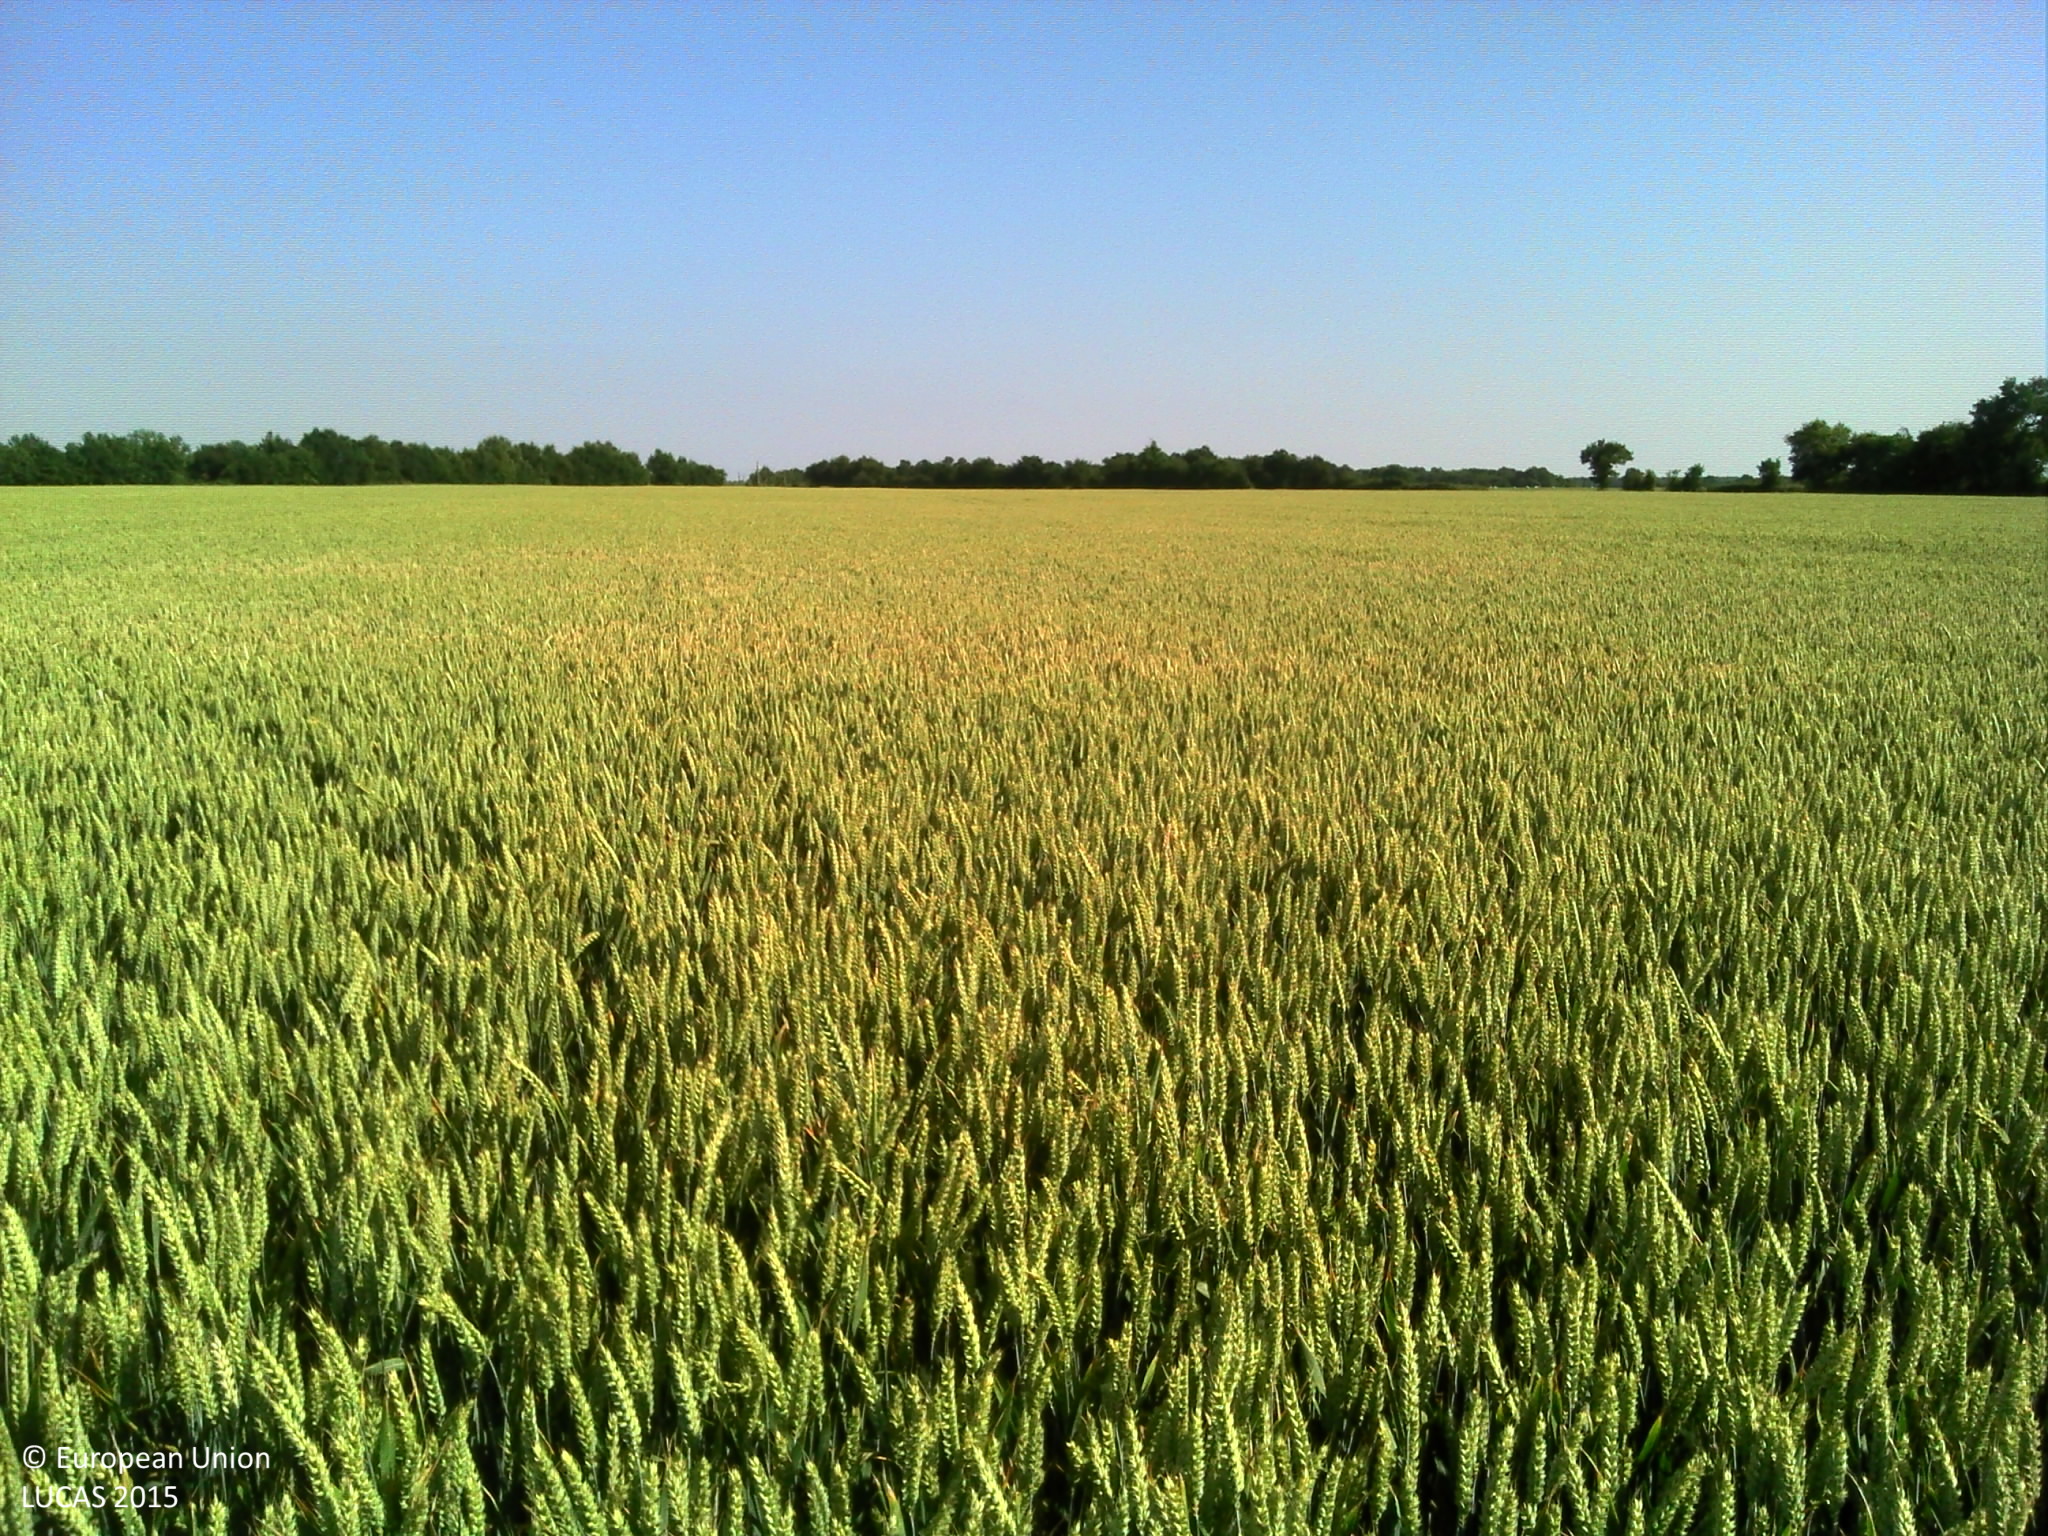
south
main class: Cropland
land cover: Common wheat
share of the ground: > 75 %
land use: Agriculture (excluding fallow land and kitchen gardens)
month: June
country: FR
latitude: 46.8887
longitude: -1.3641
